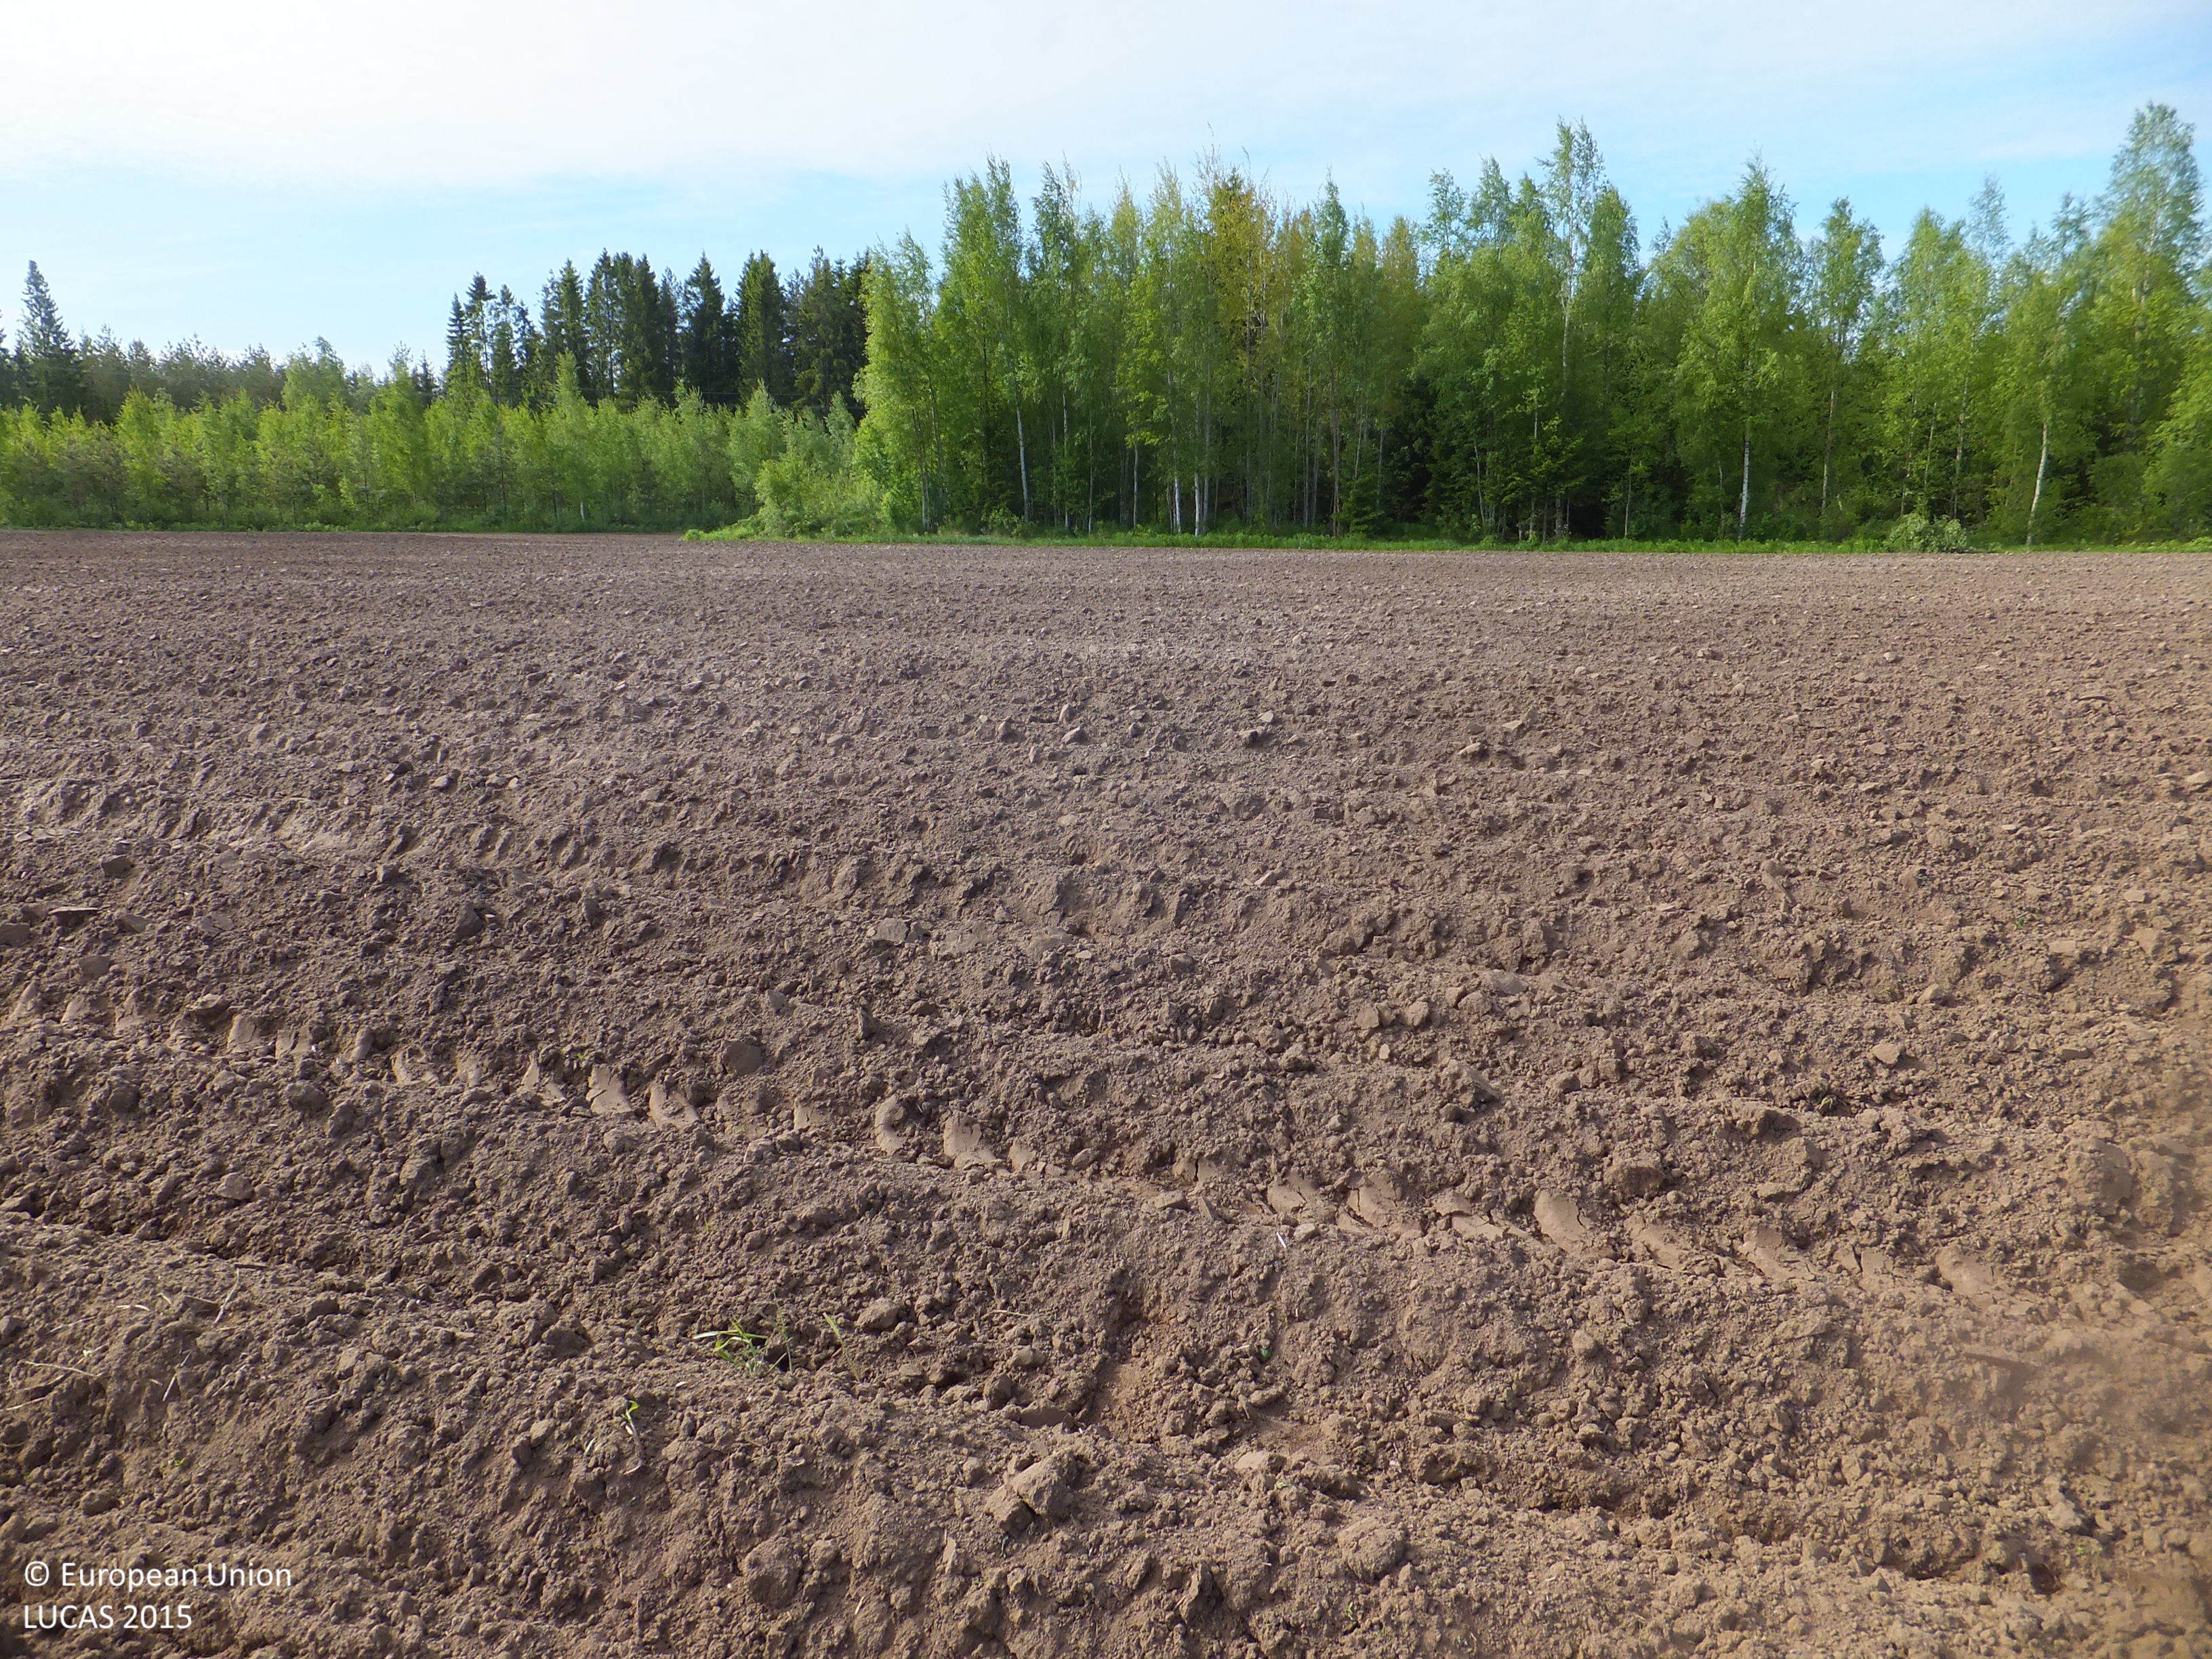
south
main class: Cropland
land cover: Barley
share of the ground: < 10 %
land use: Agriculture (excluding fallow land and kitchen gardens)
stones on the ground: < 10 %
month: June
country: FI
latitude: 63.3892
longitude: 22.7177
